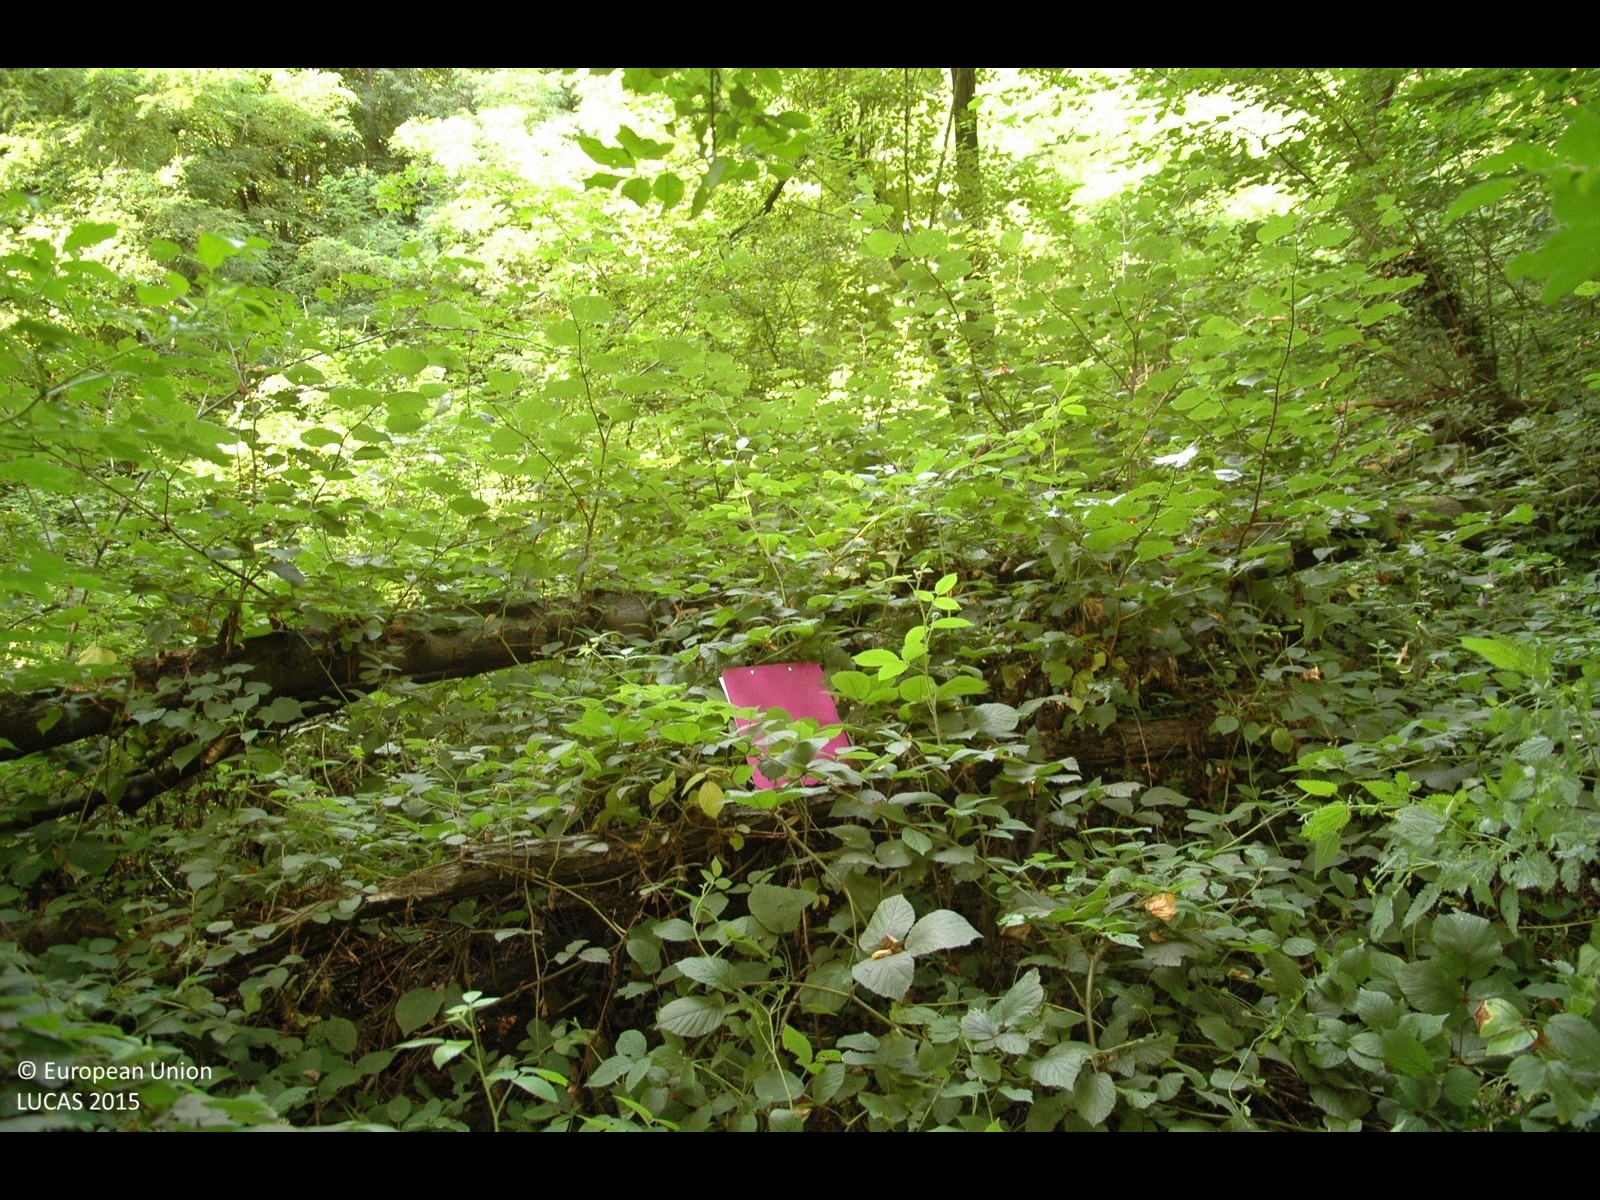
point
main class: Woodland
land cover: Broadleaved woodland
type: mesophytic deciduous forest
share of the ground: > 75 %
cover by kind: broadleaved forest trees 100 %
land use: Forestry
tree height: > 5 m
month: July
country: HR
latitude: 46.0305
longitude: 16.1356
